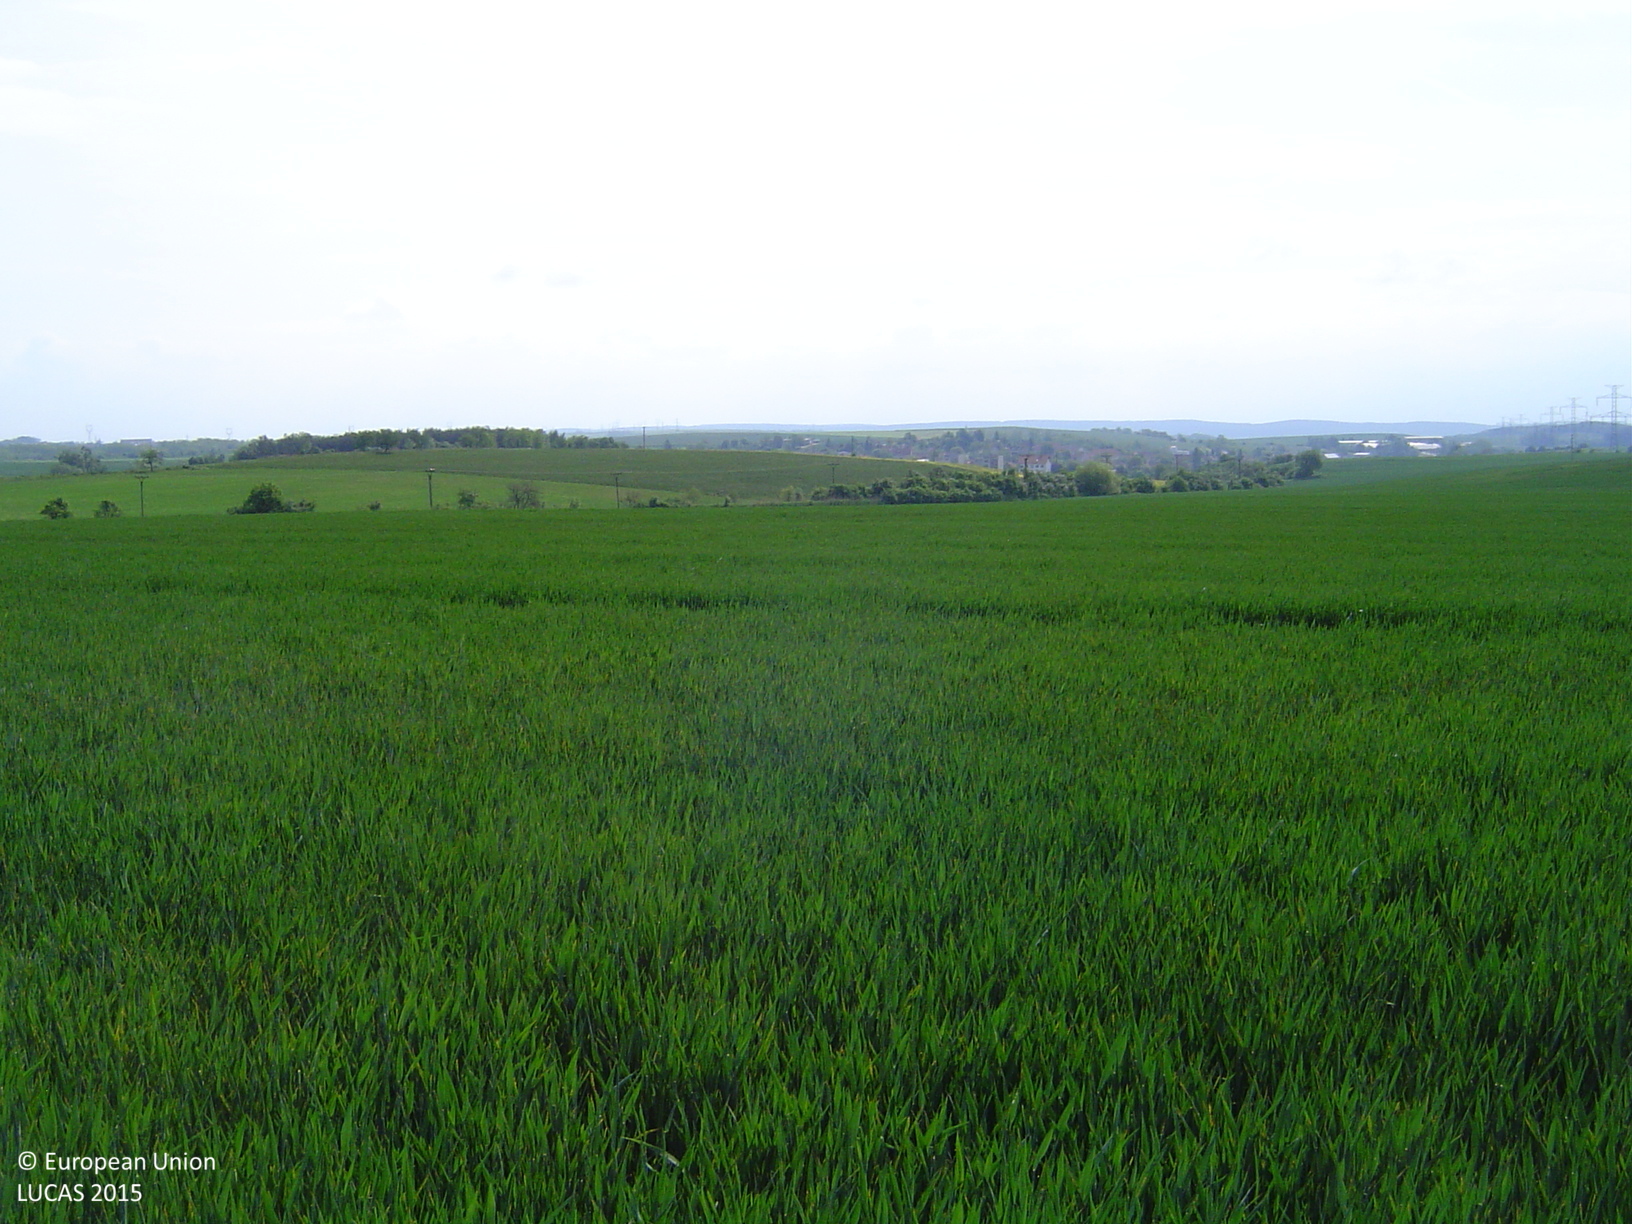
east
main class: Cropland
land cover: Common wheat
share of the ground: > 75 %
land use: Agriculture (excluding fallow land and kitchen gardens)
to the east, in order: Common wheat
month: May
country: CZ
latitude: 49.0592
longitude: 16.2050
